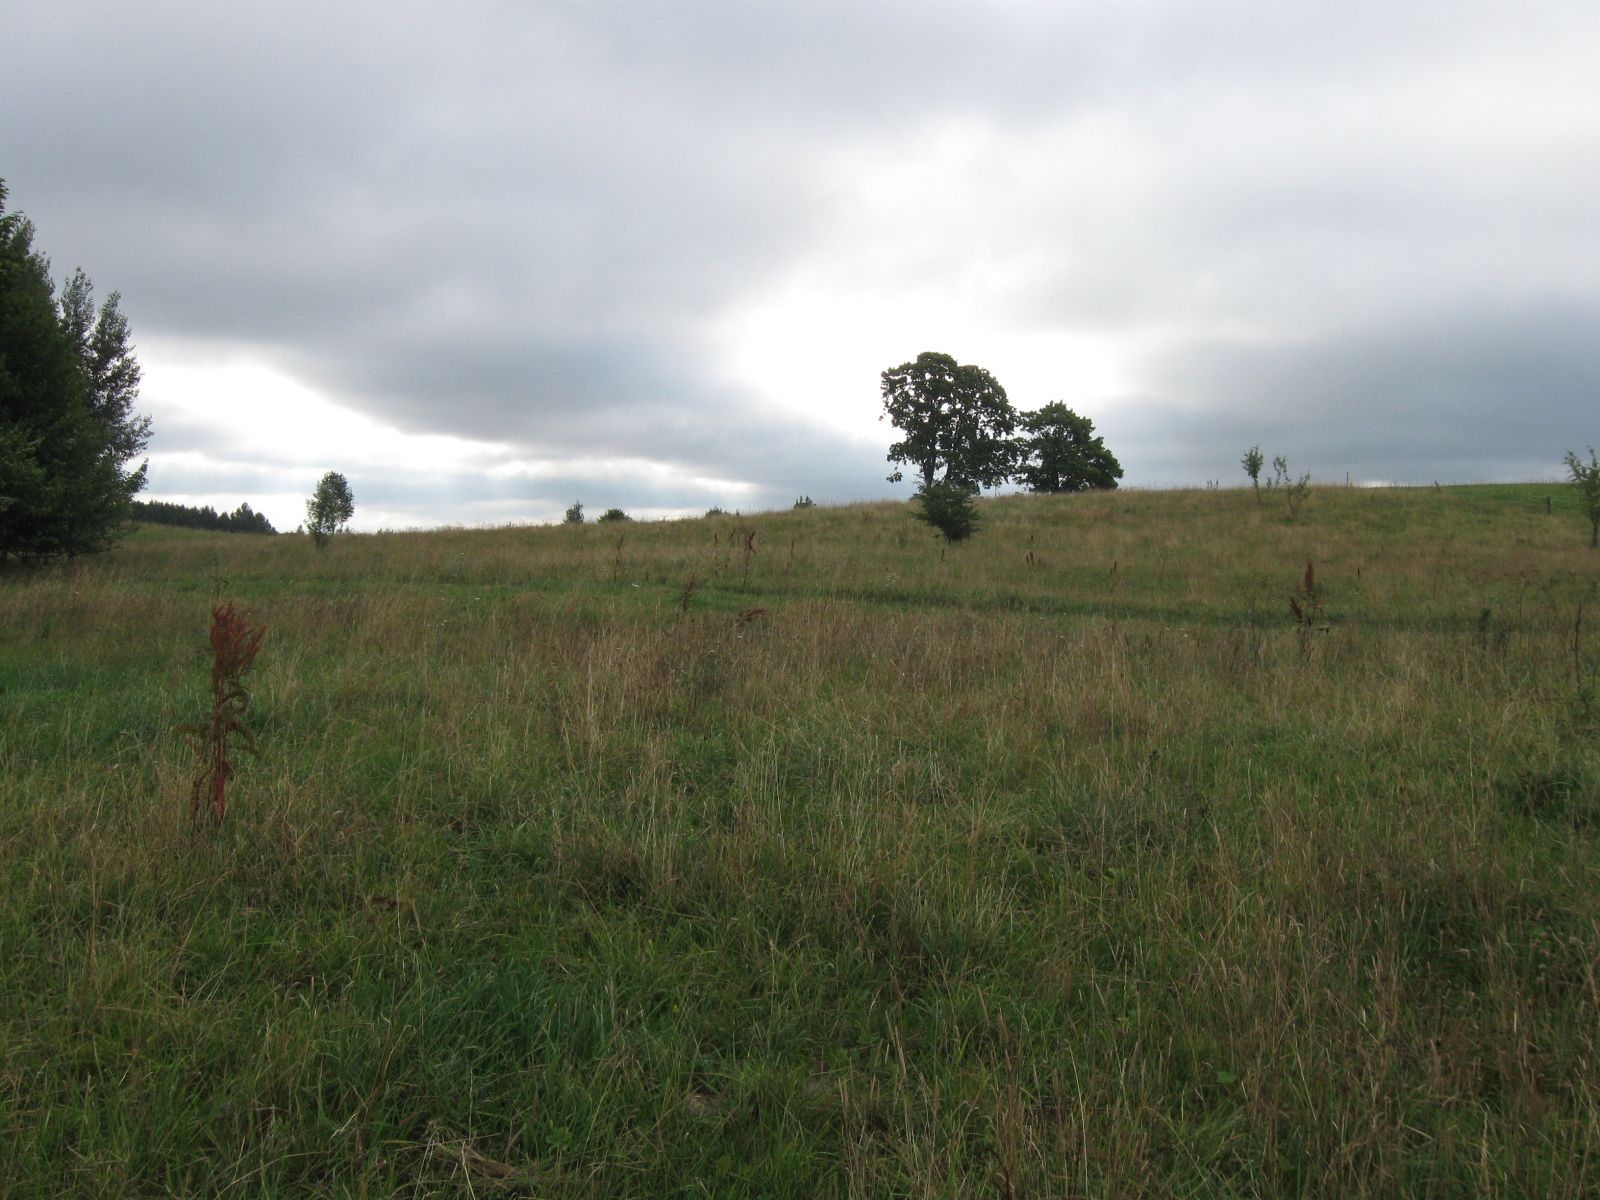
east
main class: Grassland
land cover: Grassland without tree/shrub cover
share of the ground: > 75 %
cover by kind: herbaceous plants 95 %, unconsolidated bare surface 5 %
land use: Agriculture (excluding fallow land and kitchen gardens)
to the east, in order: Grassland without tree/shrub cover; Fences; Grassland without tree/shrub cover; Tracks; Grassland without tree/shrub cover; Fences; Tracks; Grassland without tree/shrub cover; Fences; Grassland without tree/shrub cover; Lines of trees; Potatoes
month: July
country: LT
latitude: 54.3953
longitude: 24.2837
